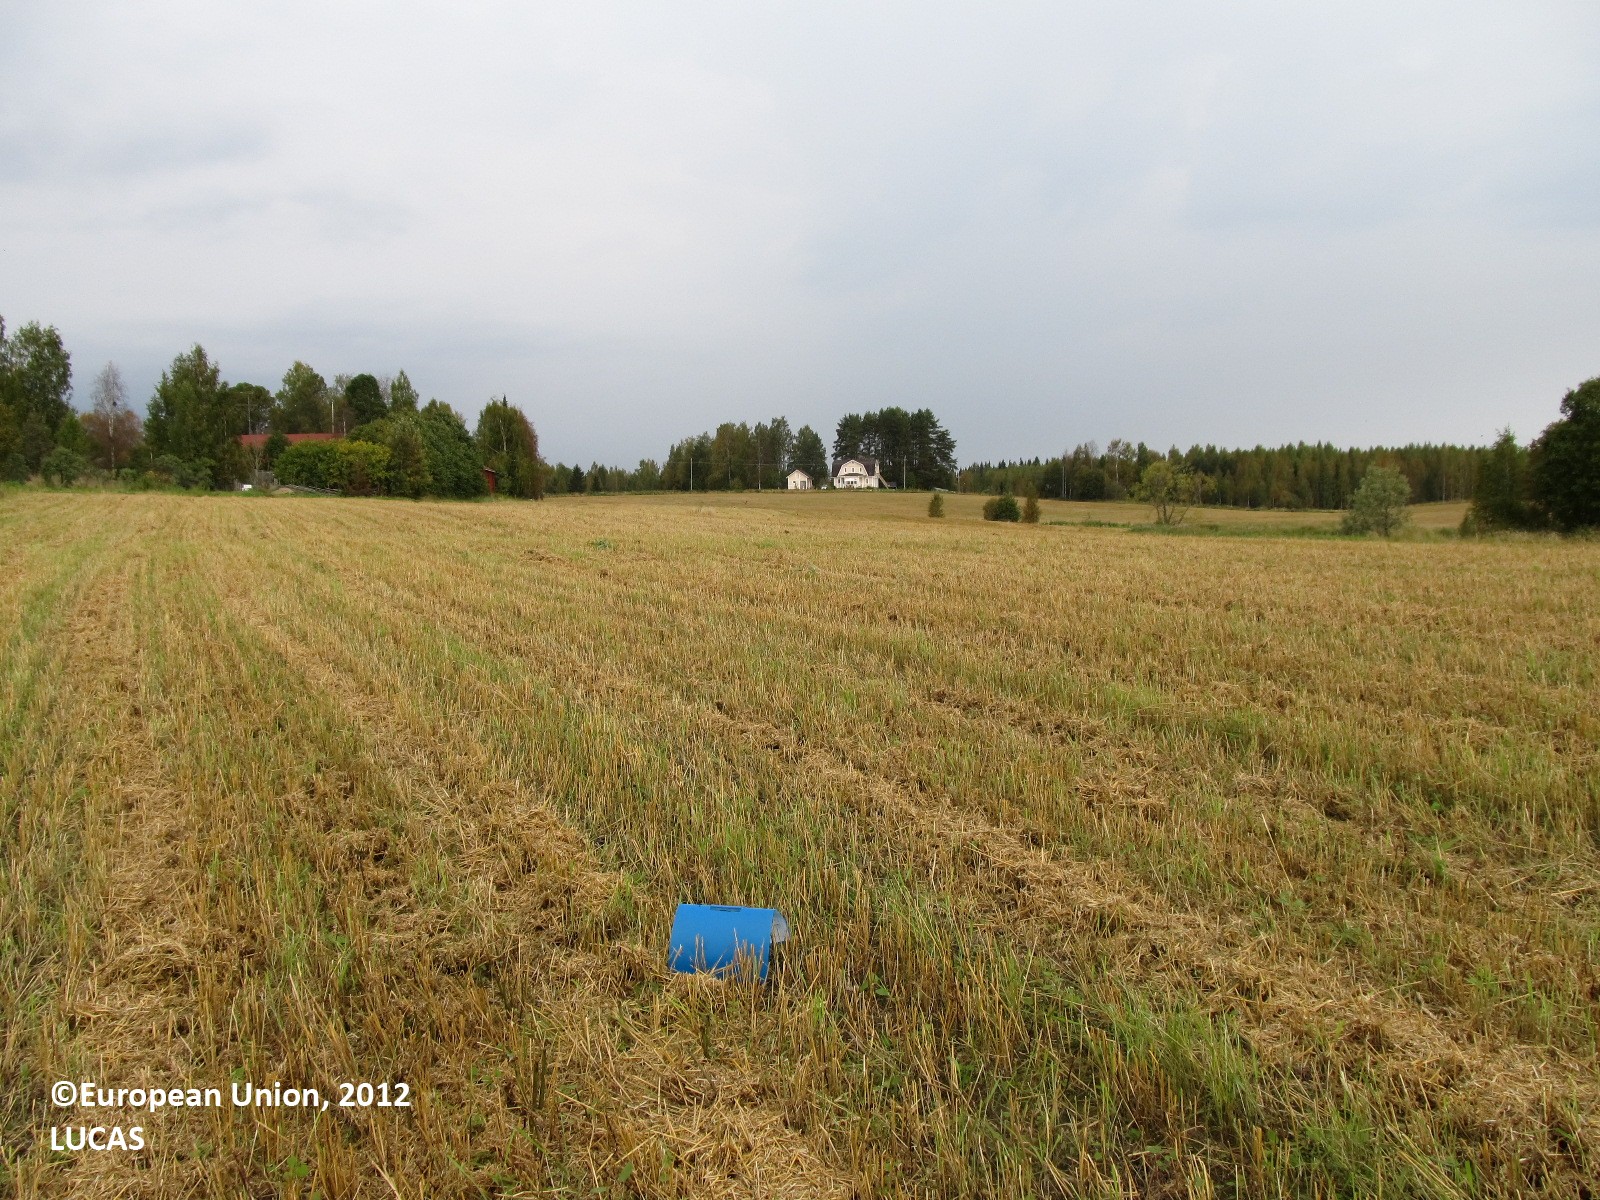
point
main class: Cropland
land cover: Common wheat
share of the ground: 50 - 75 %
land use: Agriculture (excluding fallow land and kitchen gardens)
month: September
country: FI
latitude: 63.0115
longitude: 28.2184
